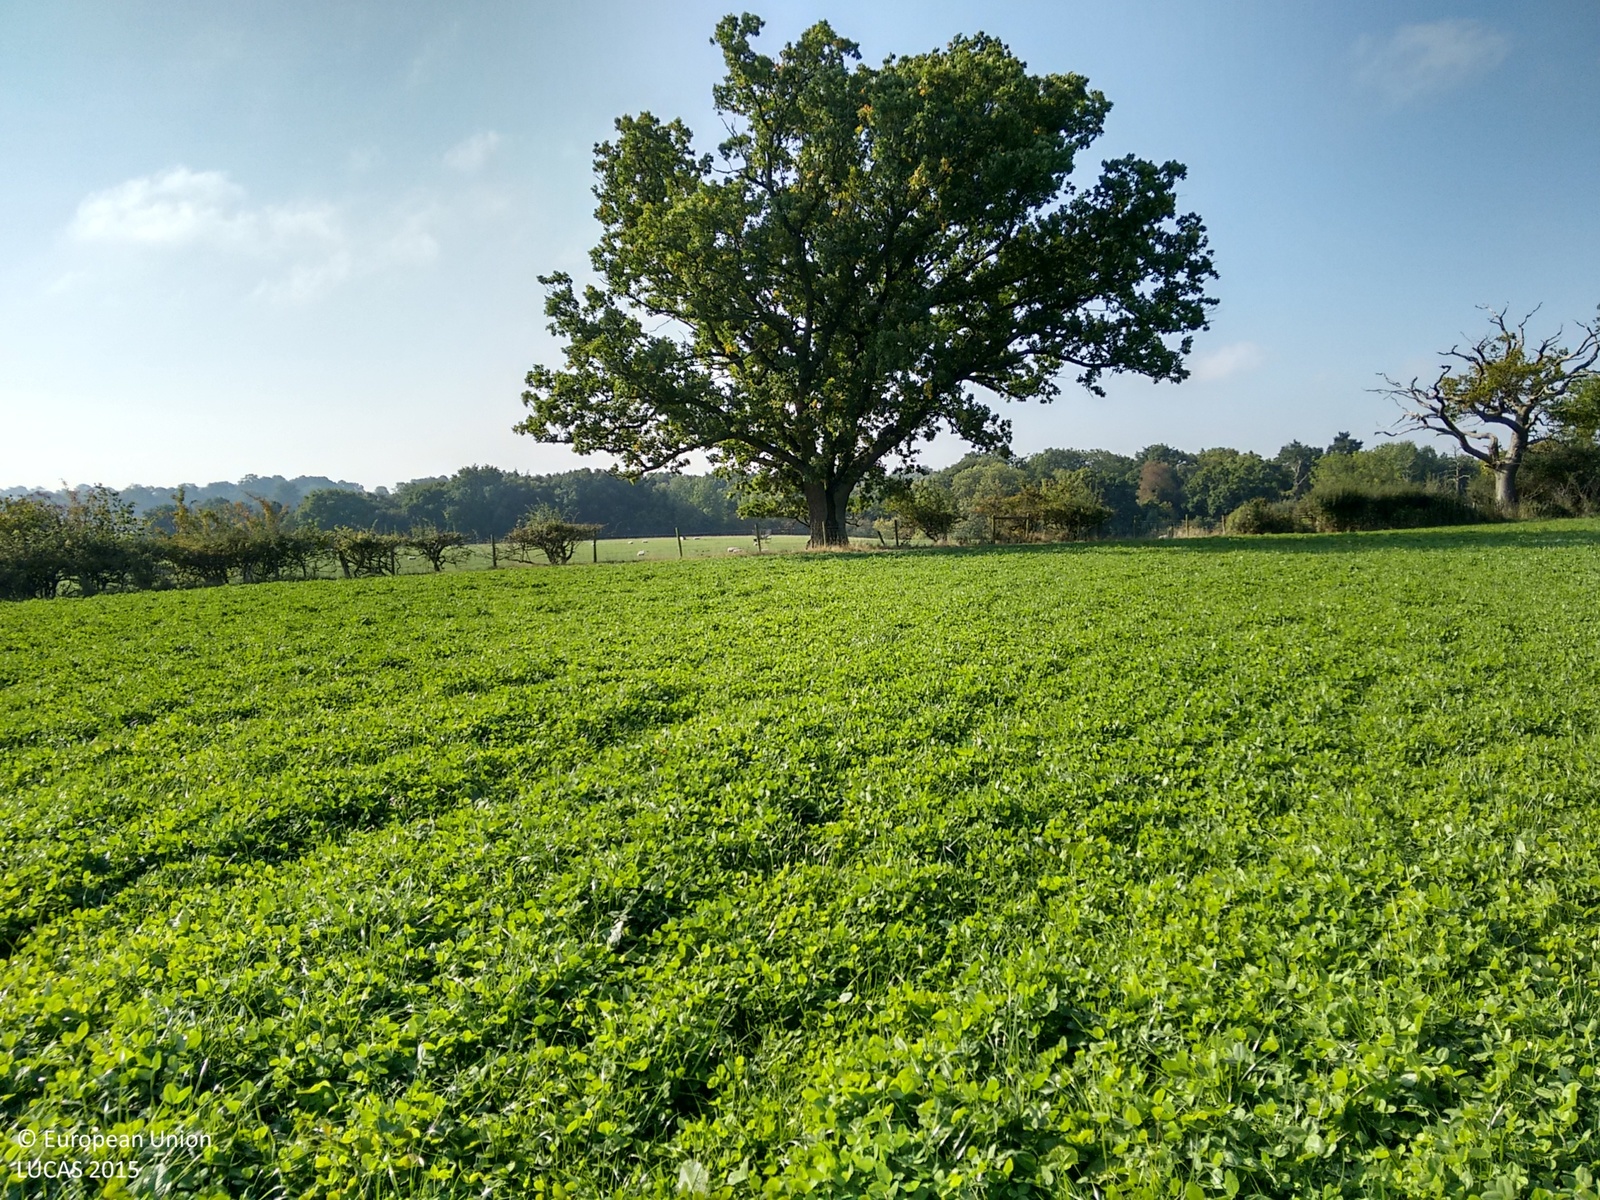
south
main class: Cropland
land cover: Clovers
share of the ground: > 75 %
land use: Agriculture (excluding fallow land and kitchen gardens)
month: September
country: GB
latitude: 51.7904
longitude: -2.4617
